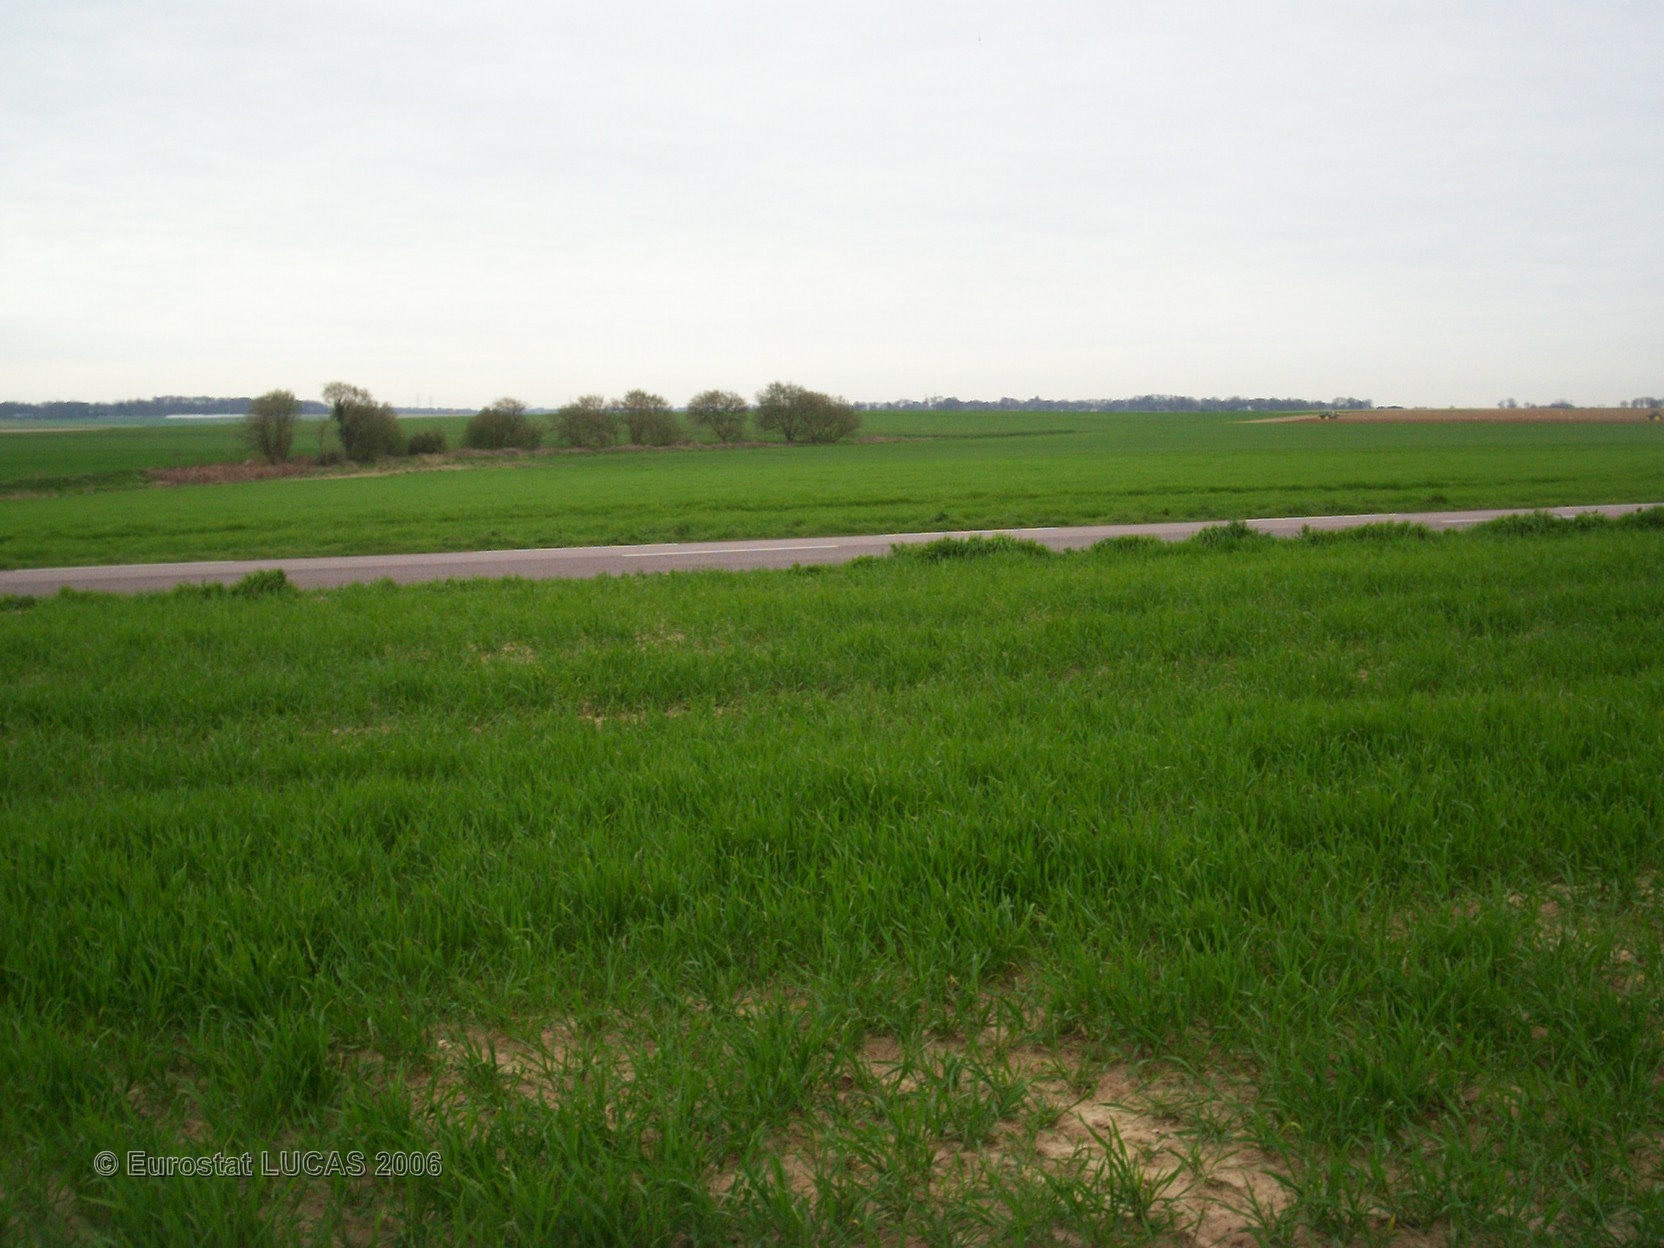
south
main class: Cropland
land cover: Common wheat
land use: Agriculture (excluding fallow land and kitchen gardens)
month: April
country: FR
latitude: 49.8642
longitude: 0.7797
